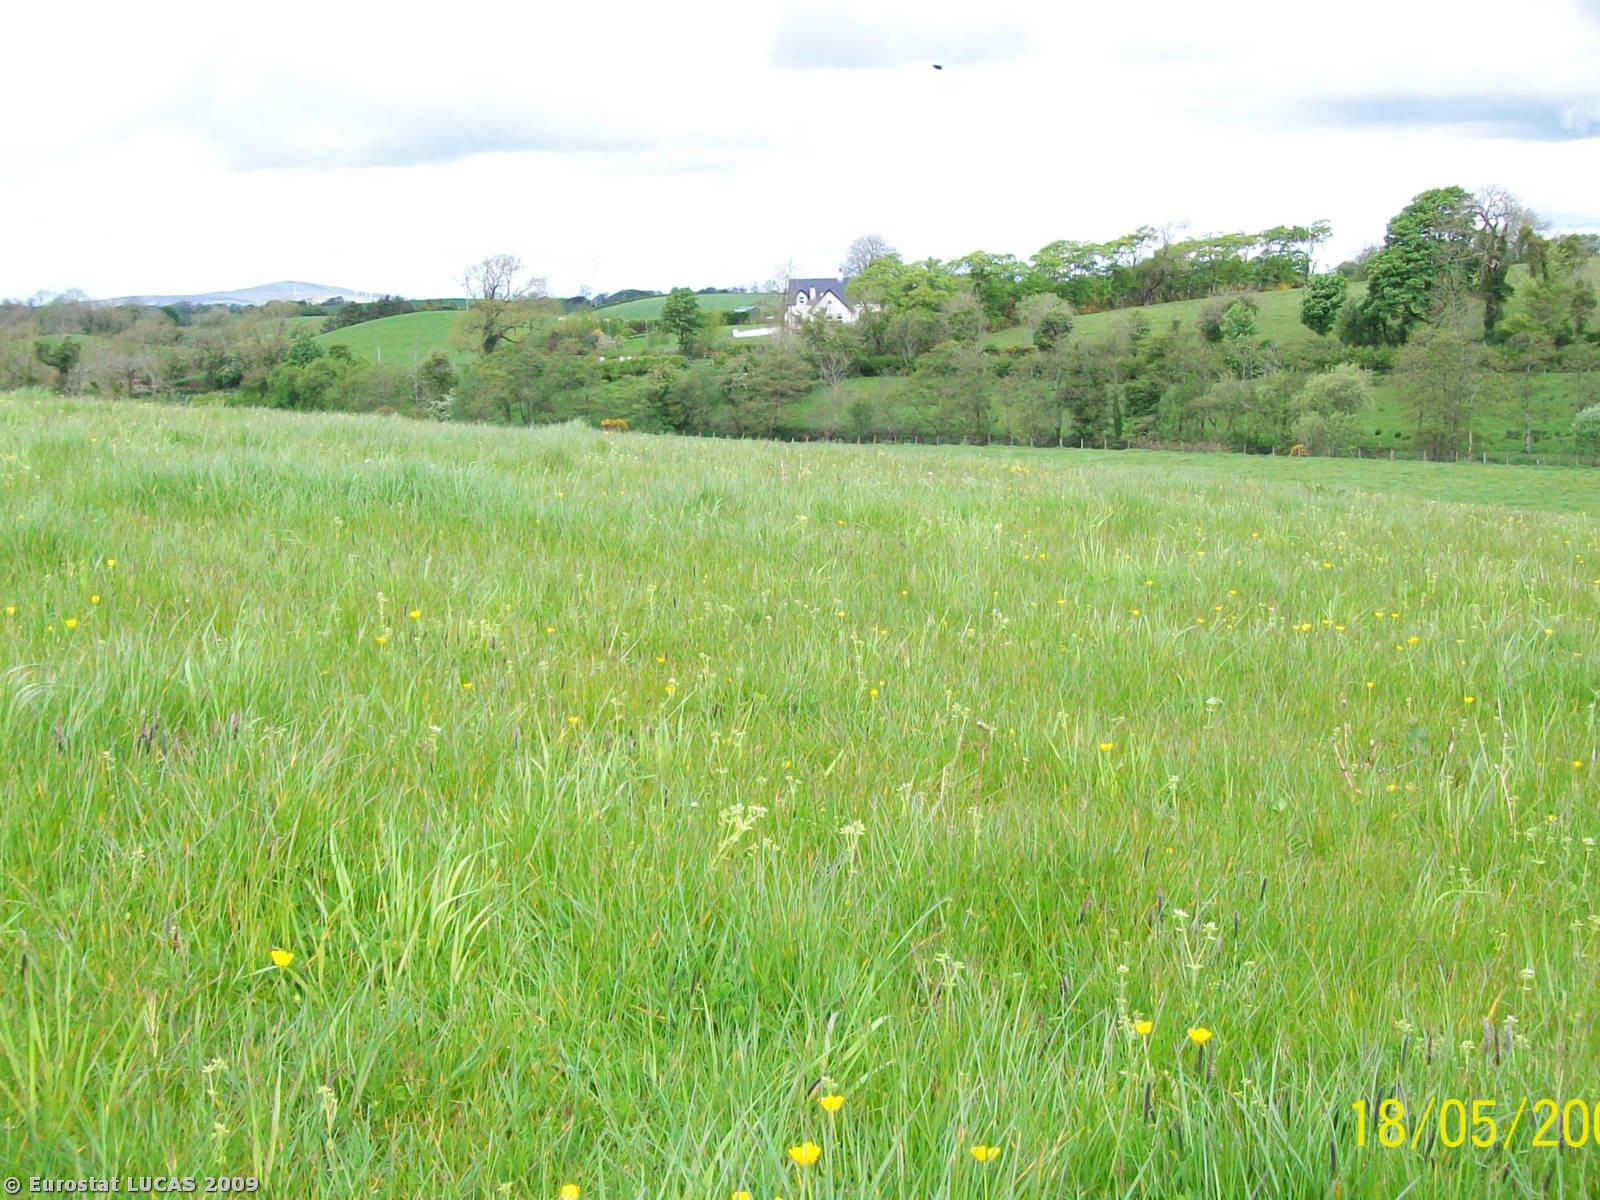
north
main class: Grassland
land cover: Grassland without tree/shrub cover
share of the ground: > 75 %
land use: Agriculture (excluding fallow land and kitchen gardens)
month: May
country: GB
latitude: 54.5523
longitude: -7.3272
